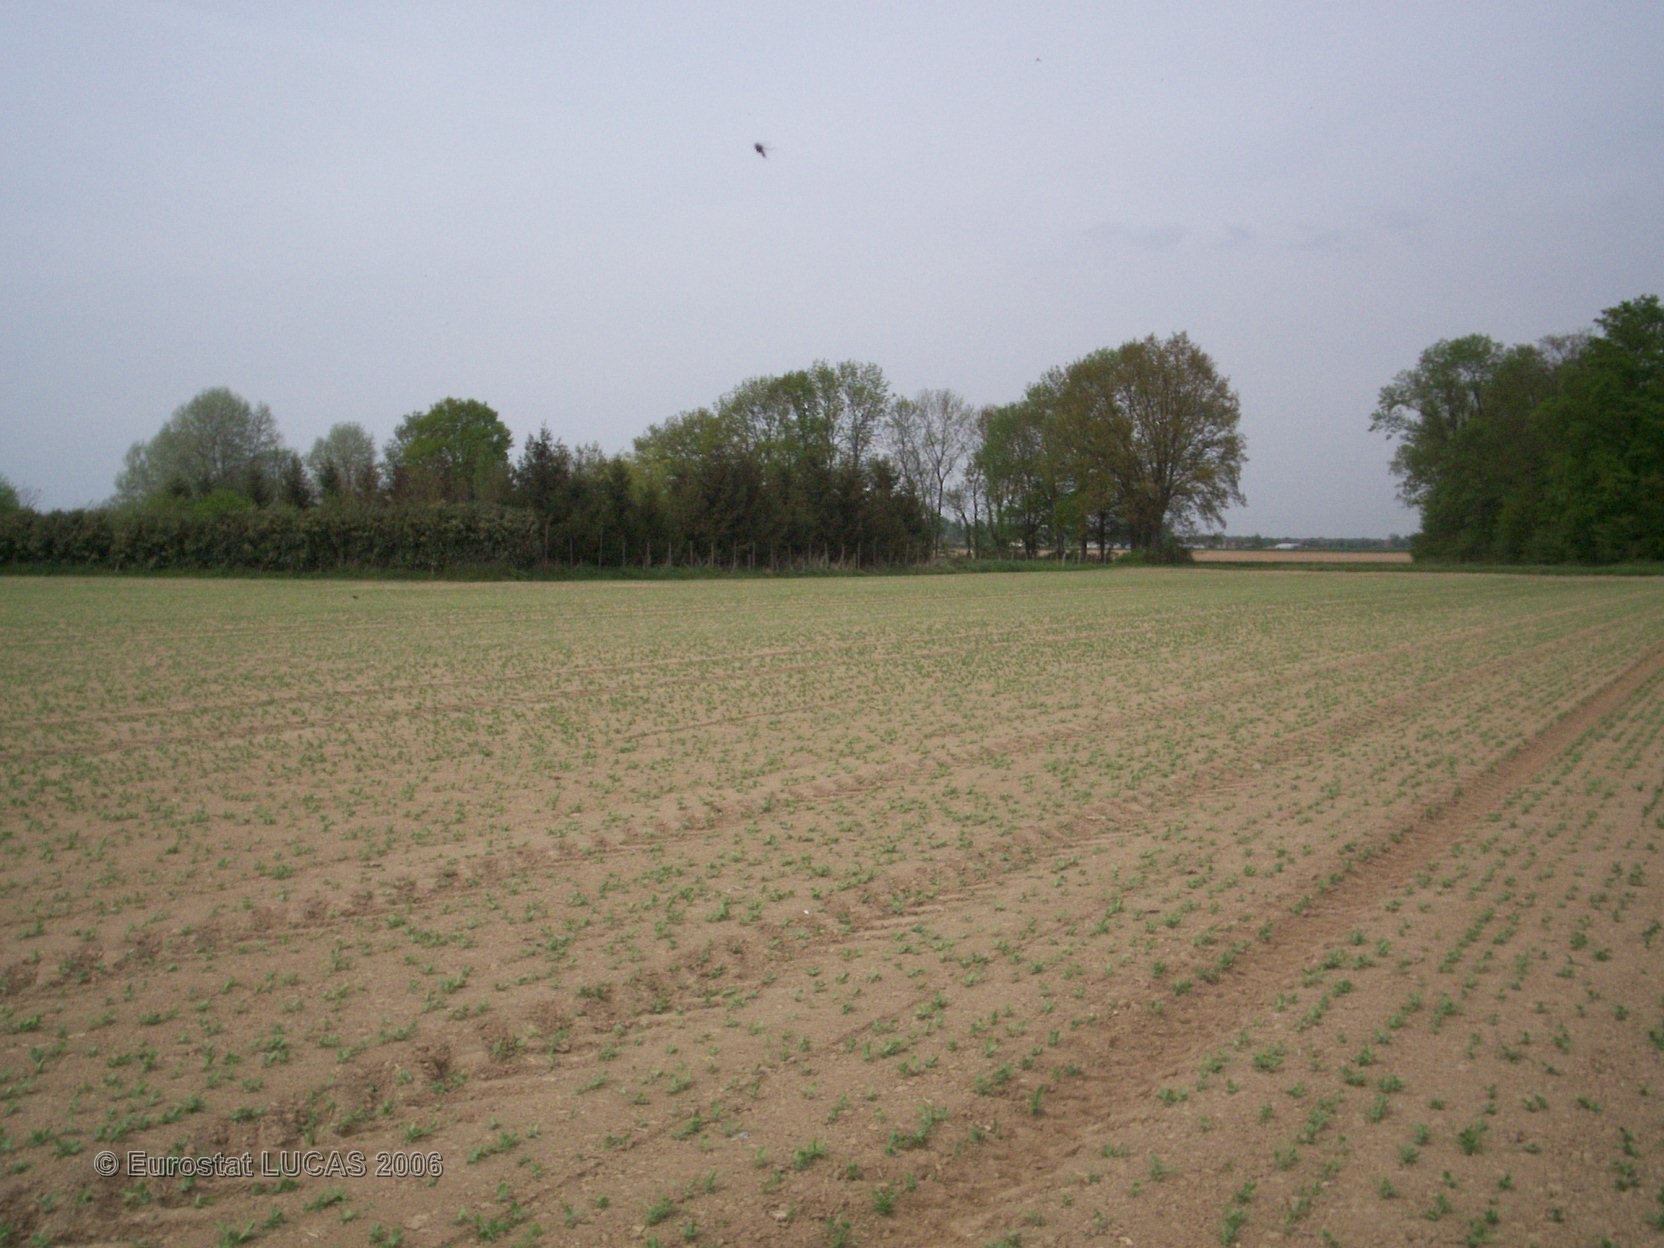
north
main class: Cropland
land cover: Dry pulses
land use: Agriculture (excluding fallow land and kitchen gardens)
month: May
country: FR
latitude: 48.7337
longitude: 2.8800
